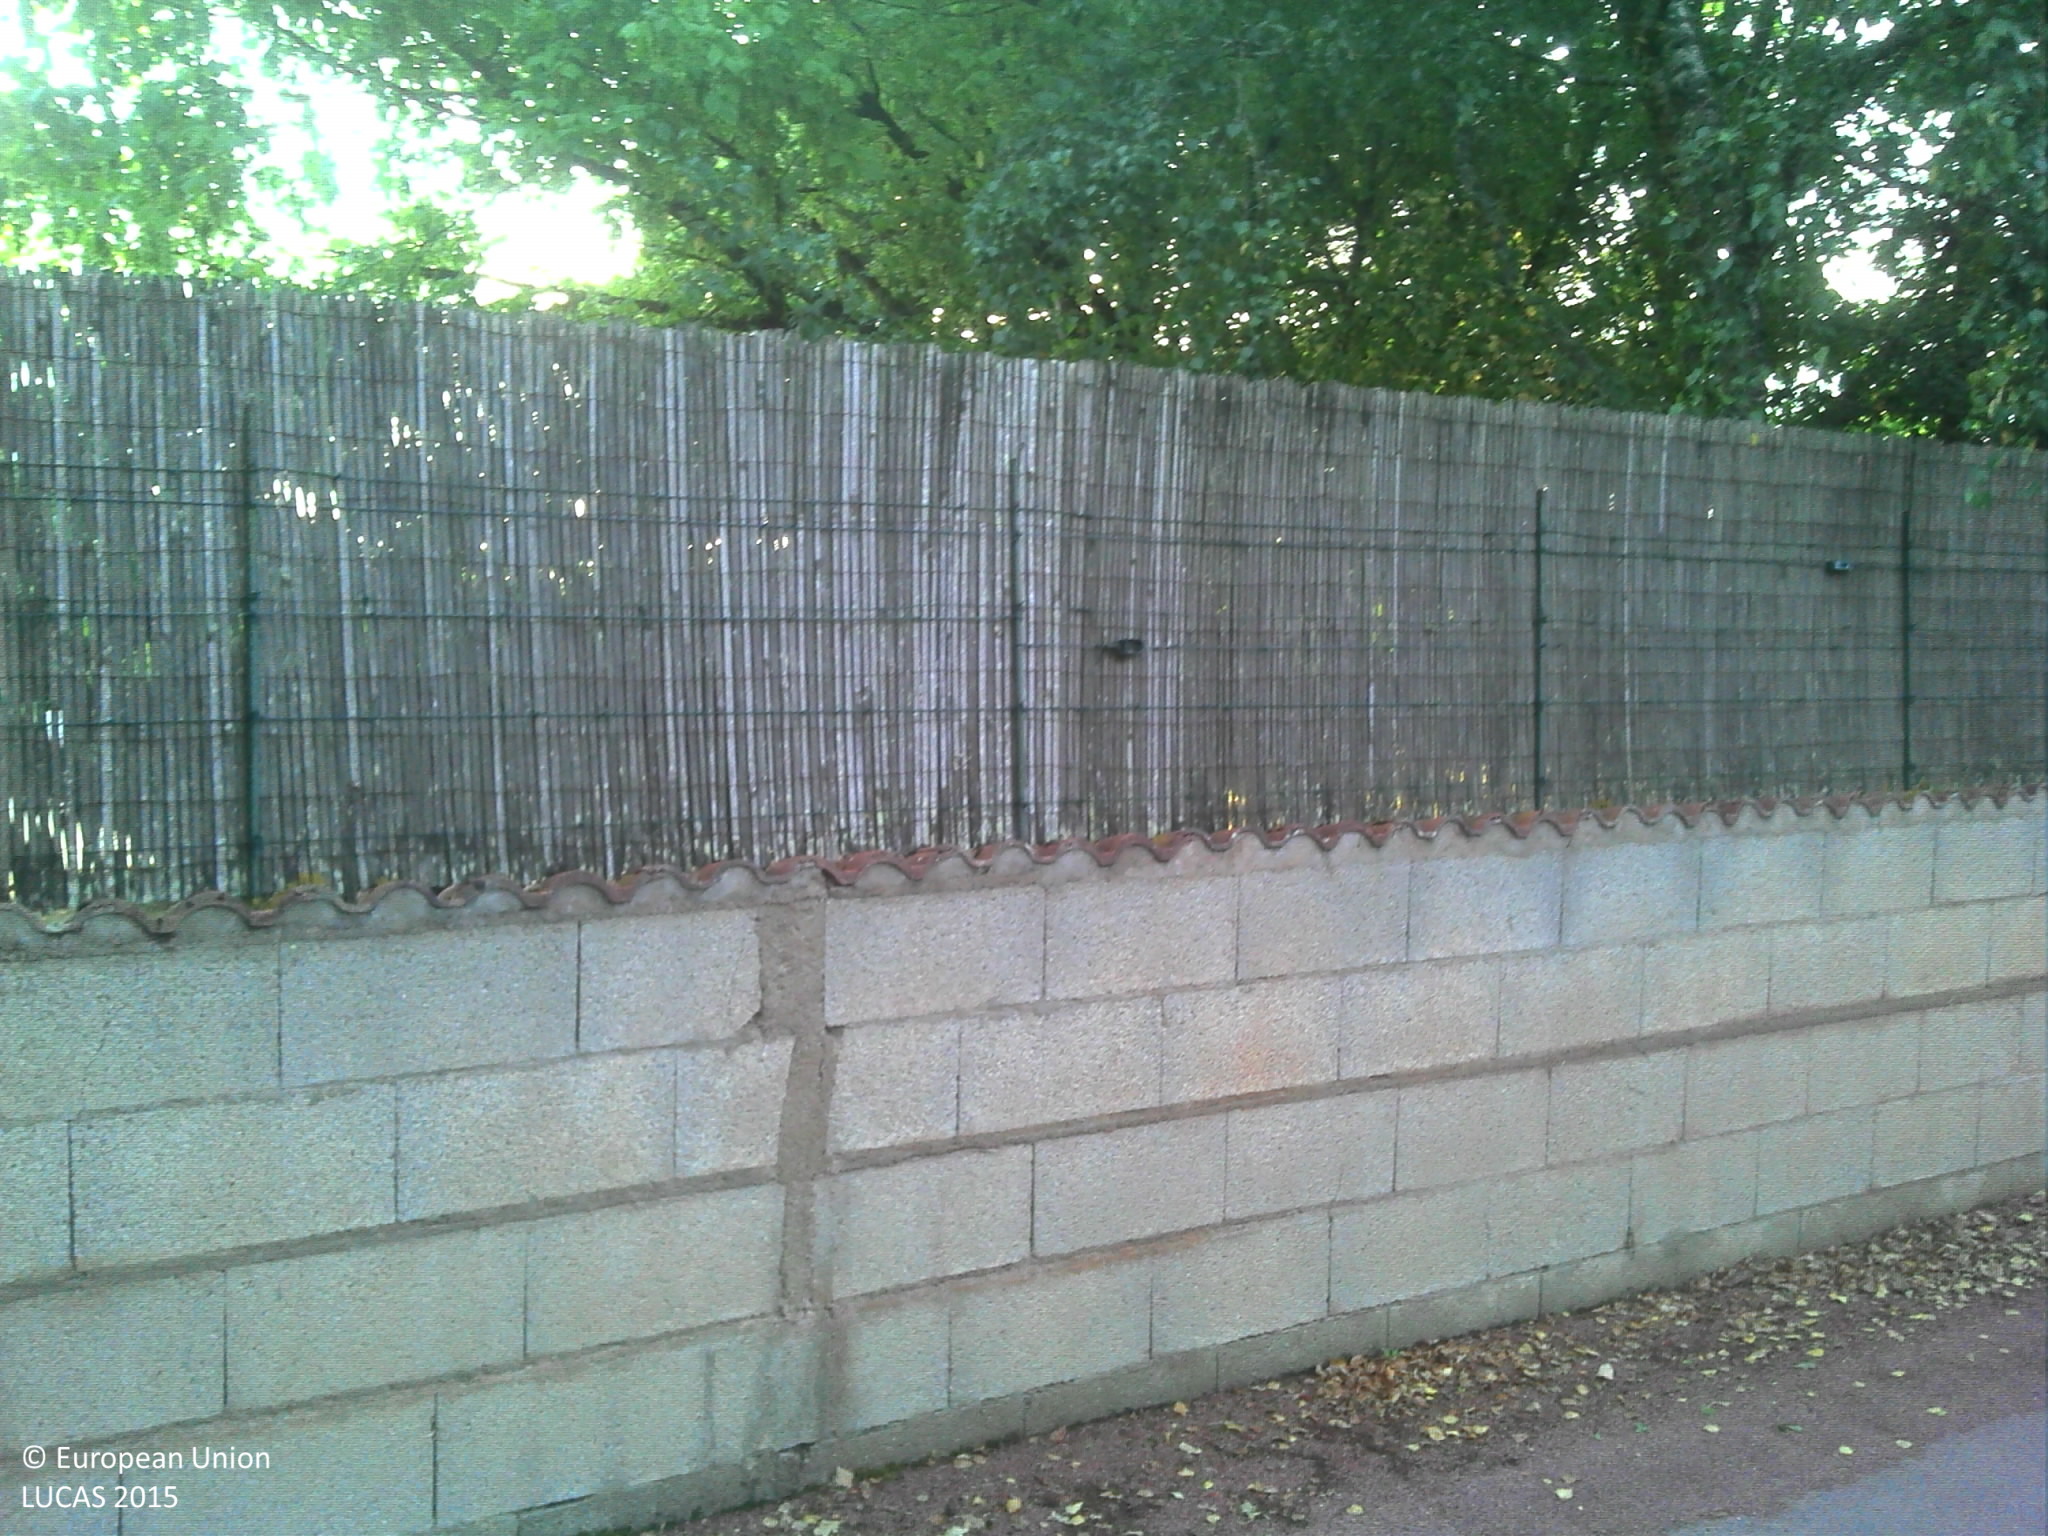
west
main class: Grassland
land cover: Grassland with sparse tree/shrub cover
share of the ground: > 75 %
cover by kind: herbaceous plants 95 %, broadleaved forest trees 5 %
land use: Residential
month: August
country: FR
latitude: 46.6467
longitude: -1.4175
